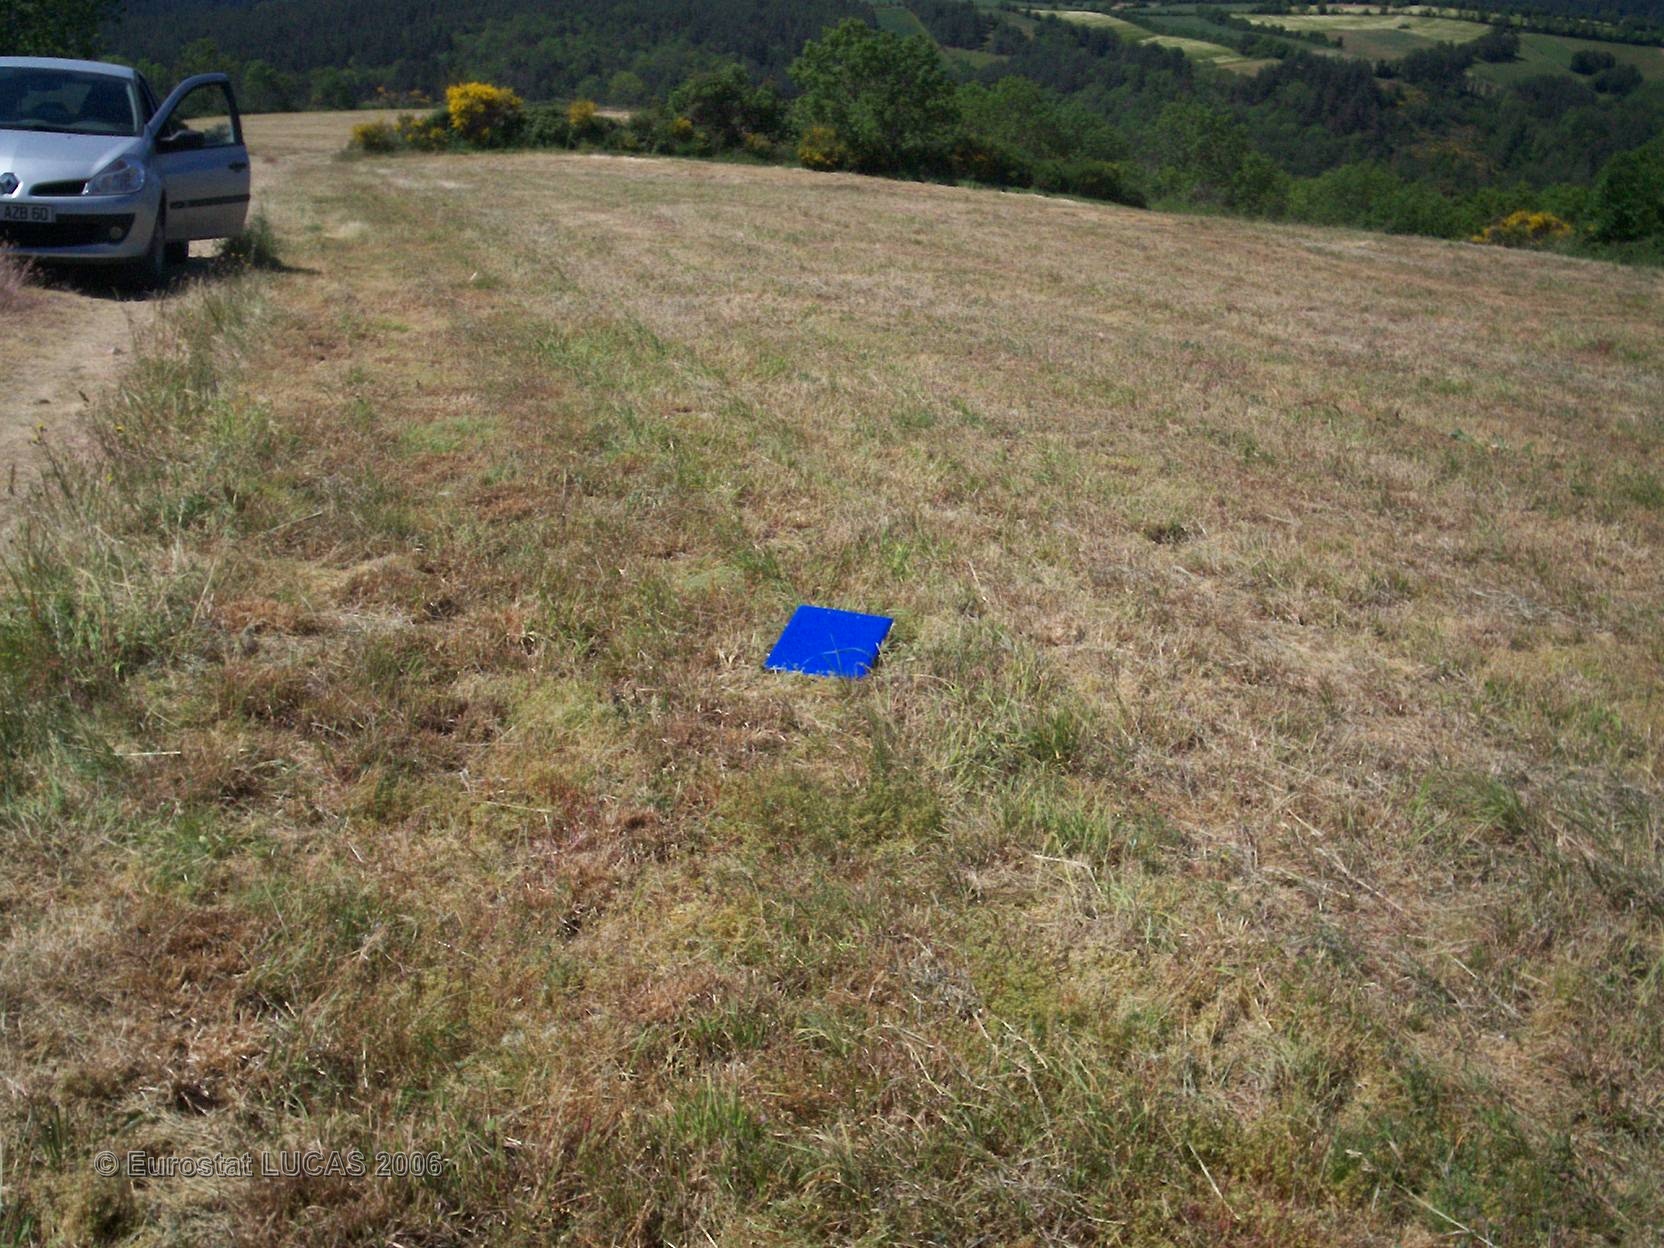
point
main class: Grassland
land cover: Grassland without tree/shrub cover
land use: Agriculture (excluding fallow land and kitchen gardens)
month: June
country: FR
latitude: 44.5398
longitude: 3.4227
